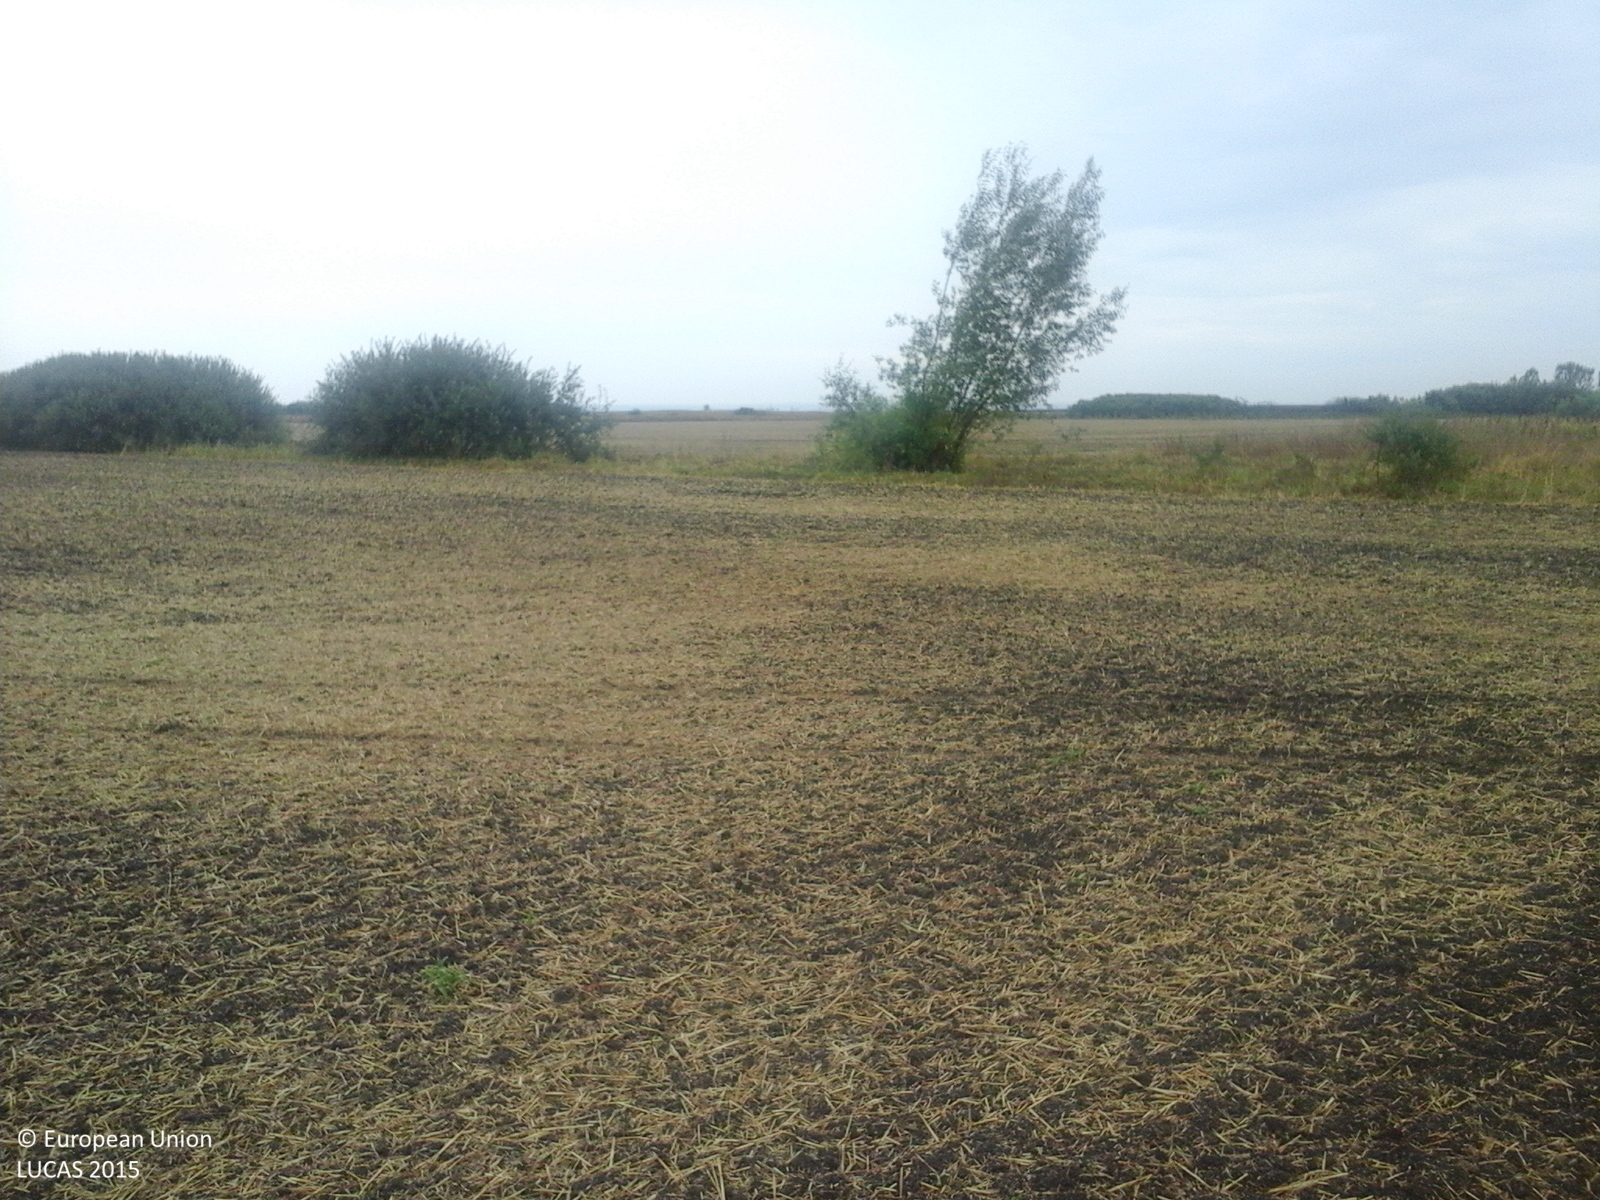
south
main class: Cropland
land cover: Common wheat
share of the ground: < 10 %
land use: Agriculture (excluding fallow land and kitchen gardens)
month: September
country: RO
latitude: 47.6091
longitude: 22.5766
